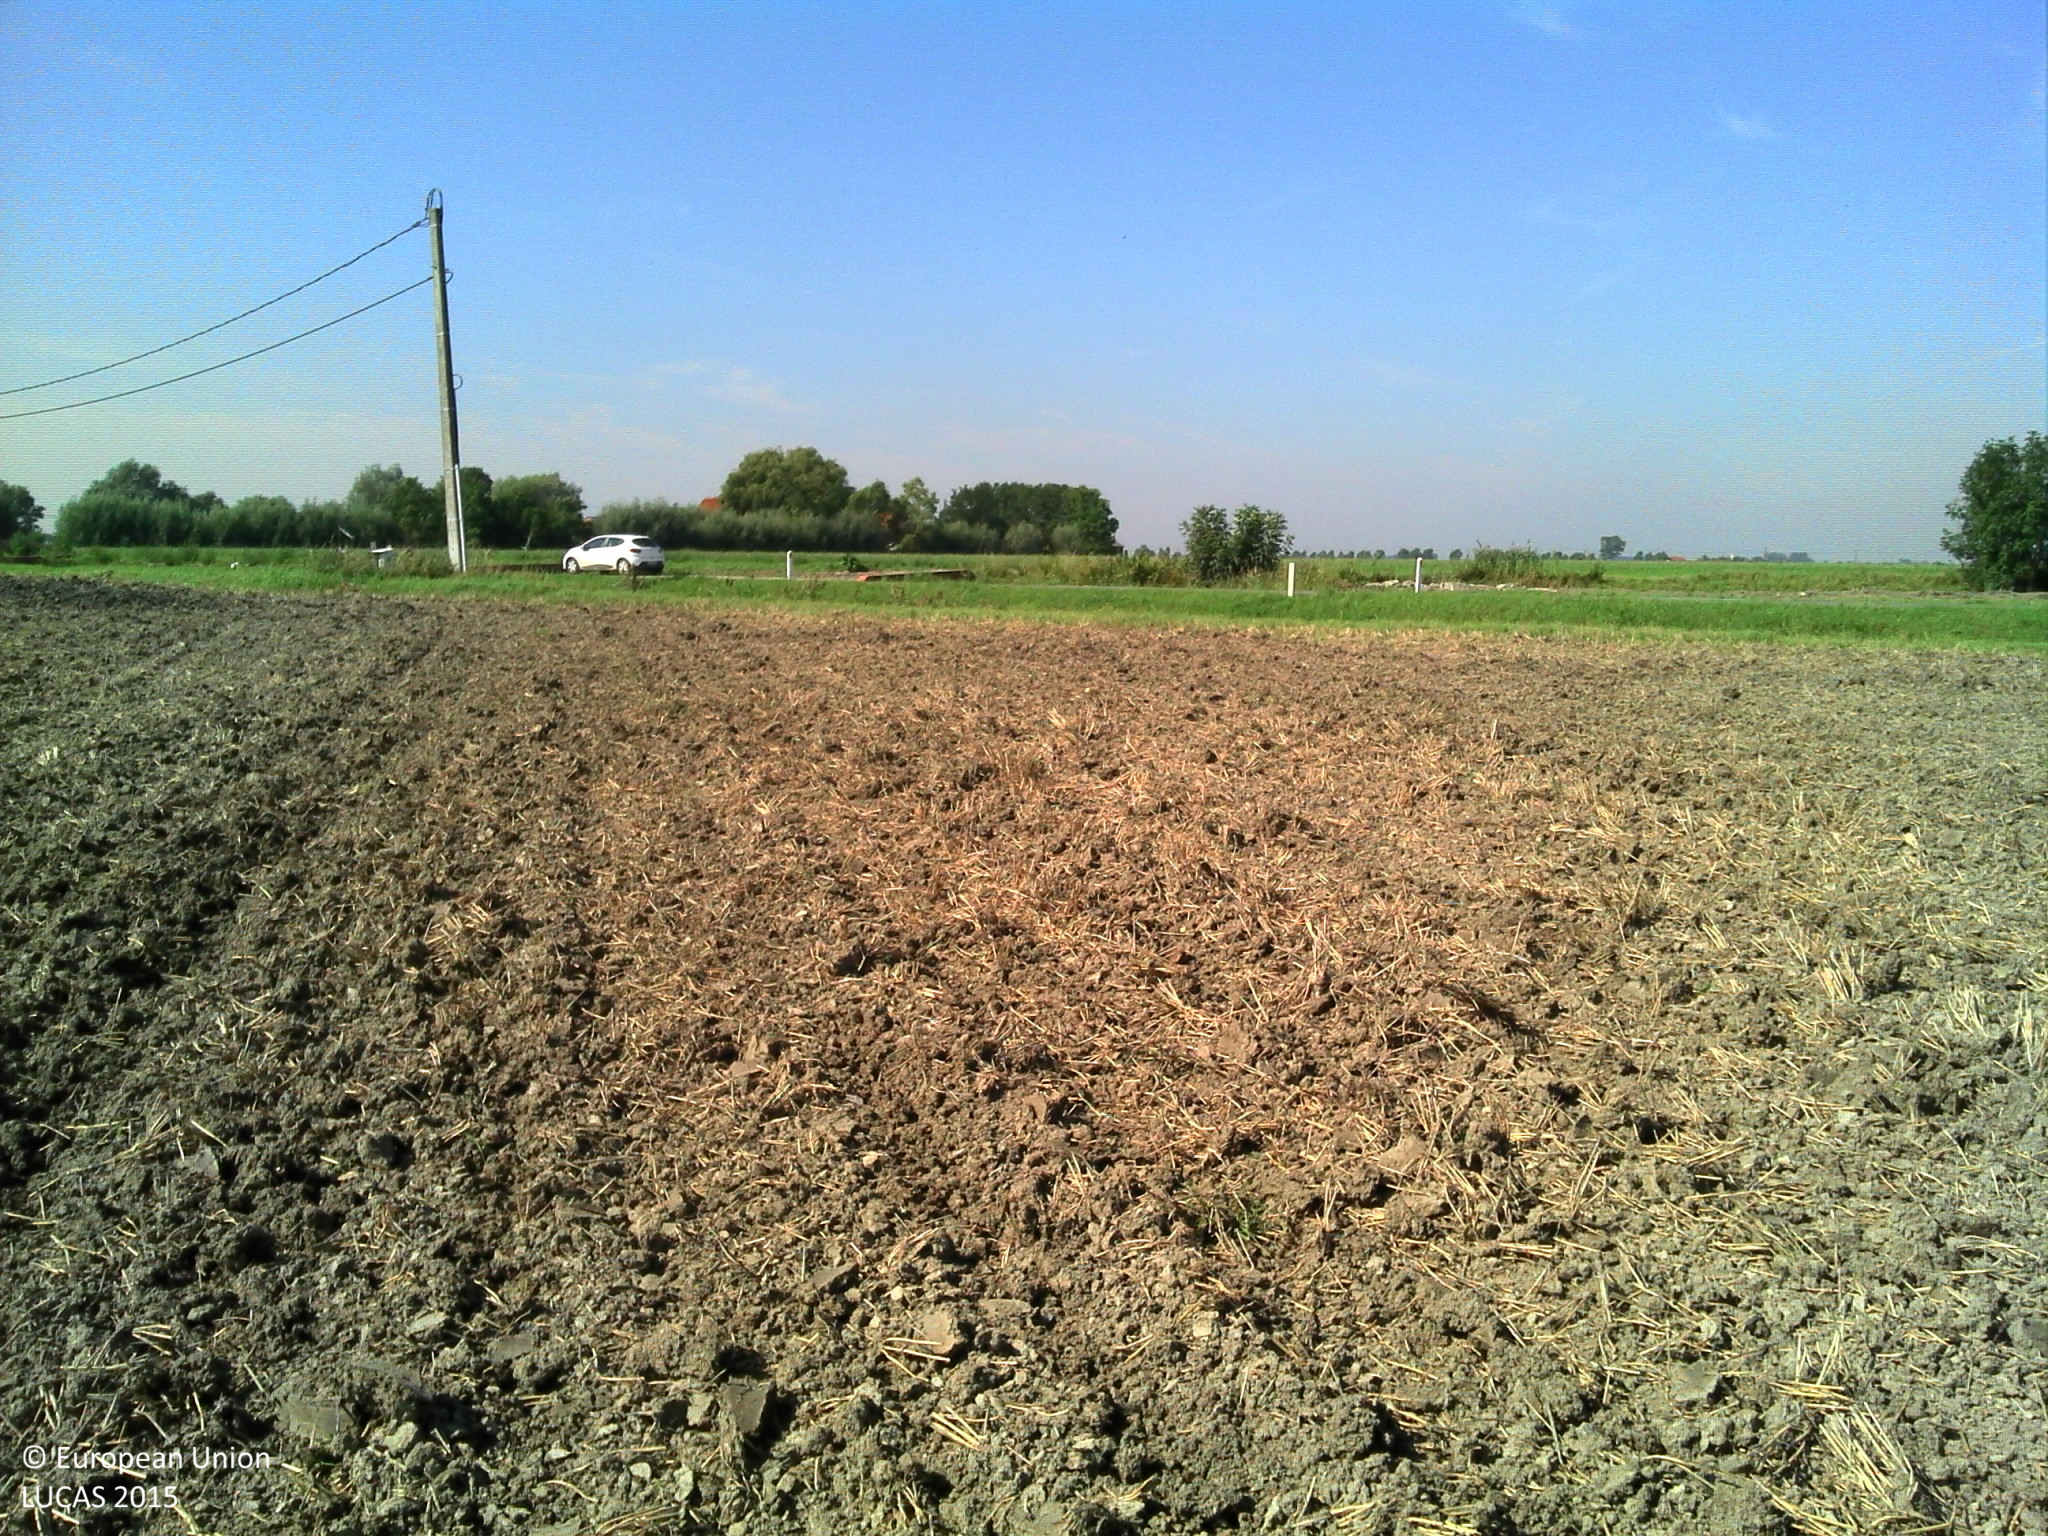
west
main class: Cropland
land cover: Common wheat
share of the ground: 50 - 75 %
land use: Agriculture (excluding fallow land and kitchen gardens)
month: September
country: BE
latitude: 51.0227
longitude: 2.8178
